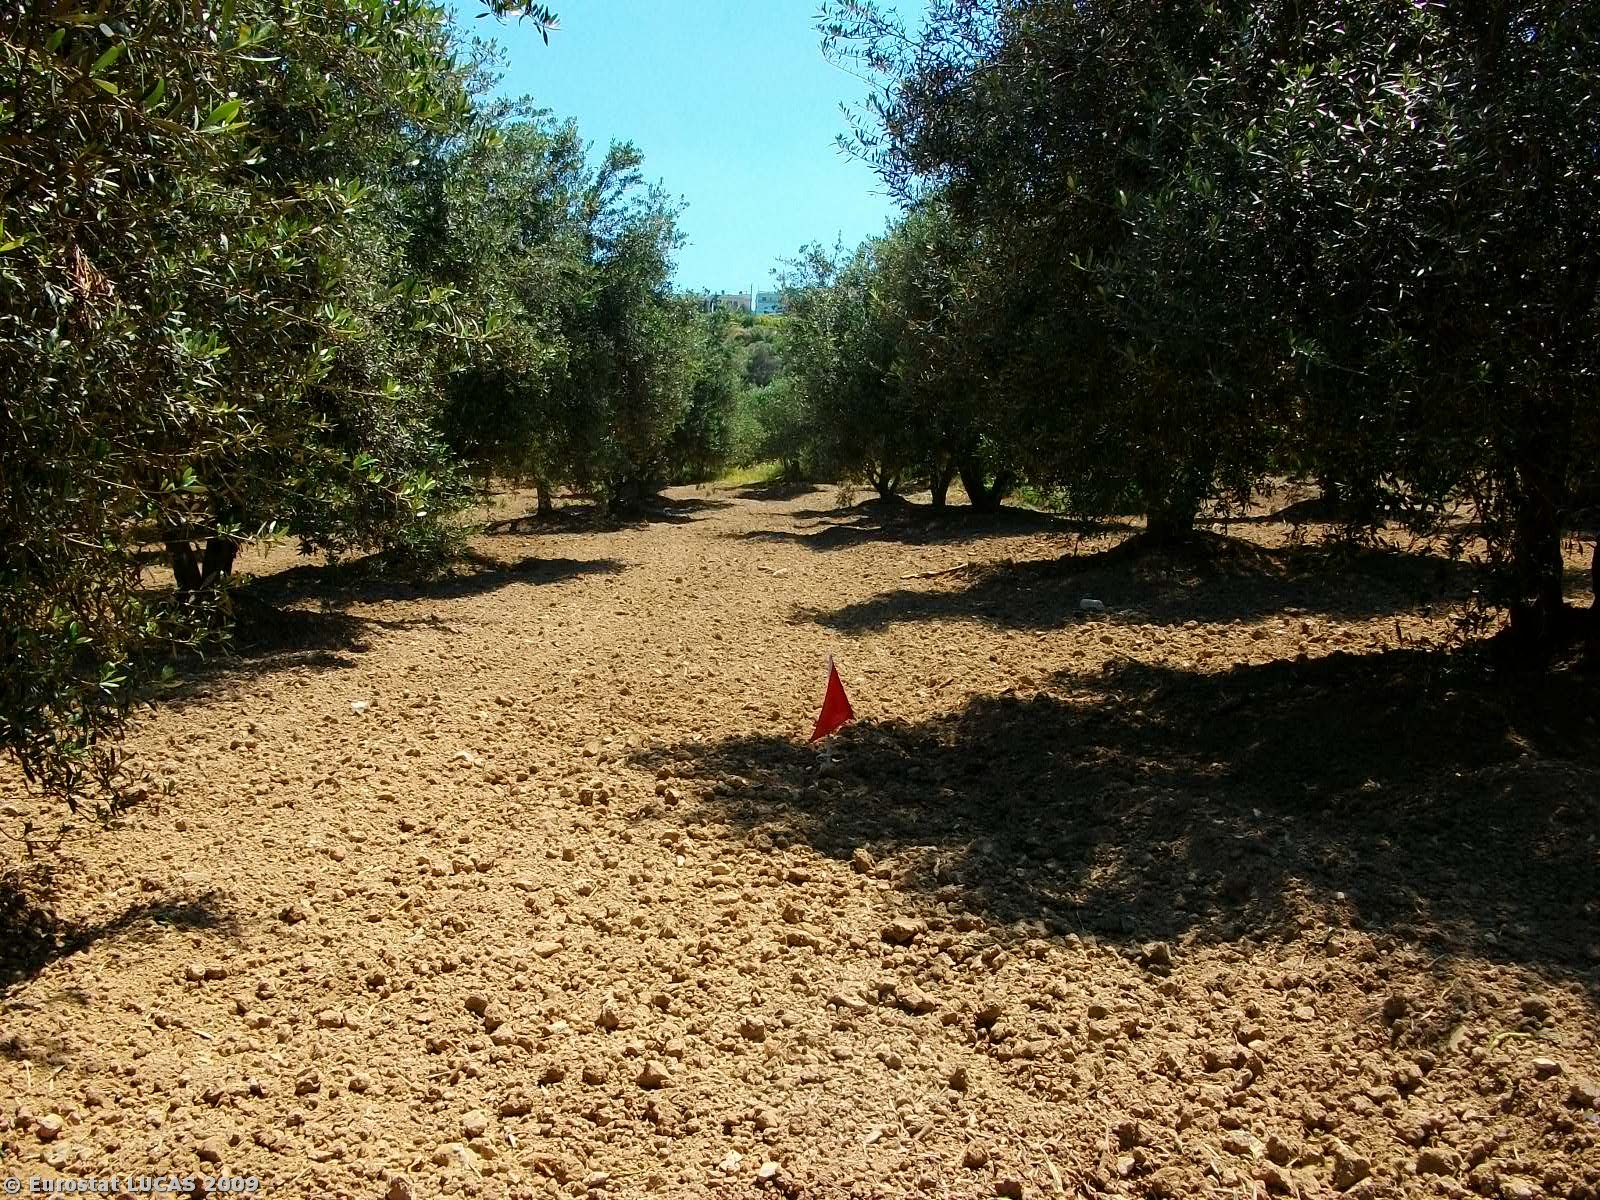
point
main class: Cropland
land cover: Olive groves
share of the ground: 50 - 75 %
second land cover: Bare land
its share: > 75 %
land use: Agriculture (excluding fallow land and kitchen gardens)
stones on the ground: < 10 %
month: May
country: GR
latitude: 35.2084
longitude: 25.0942
